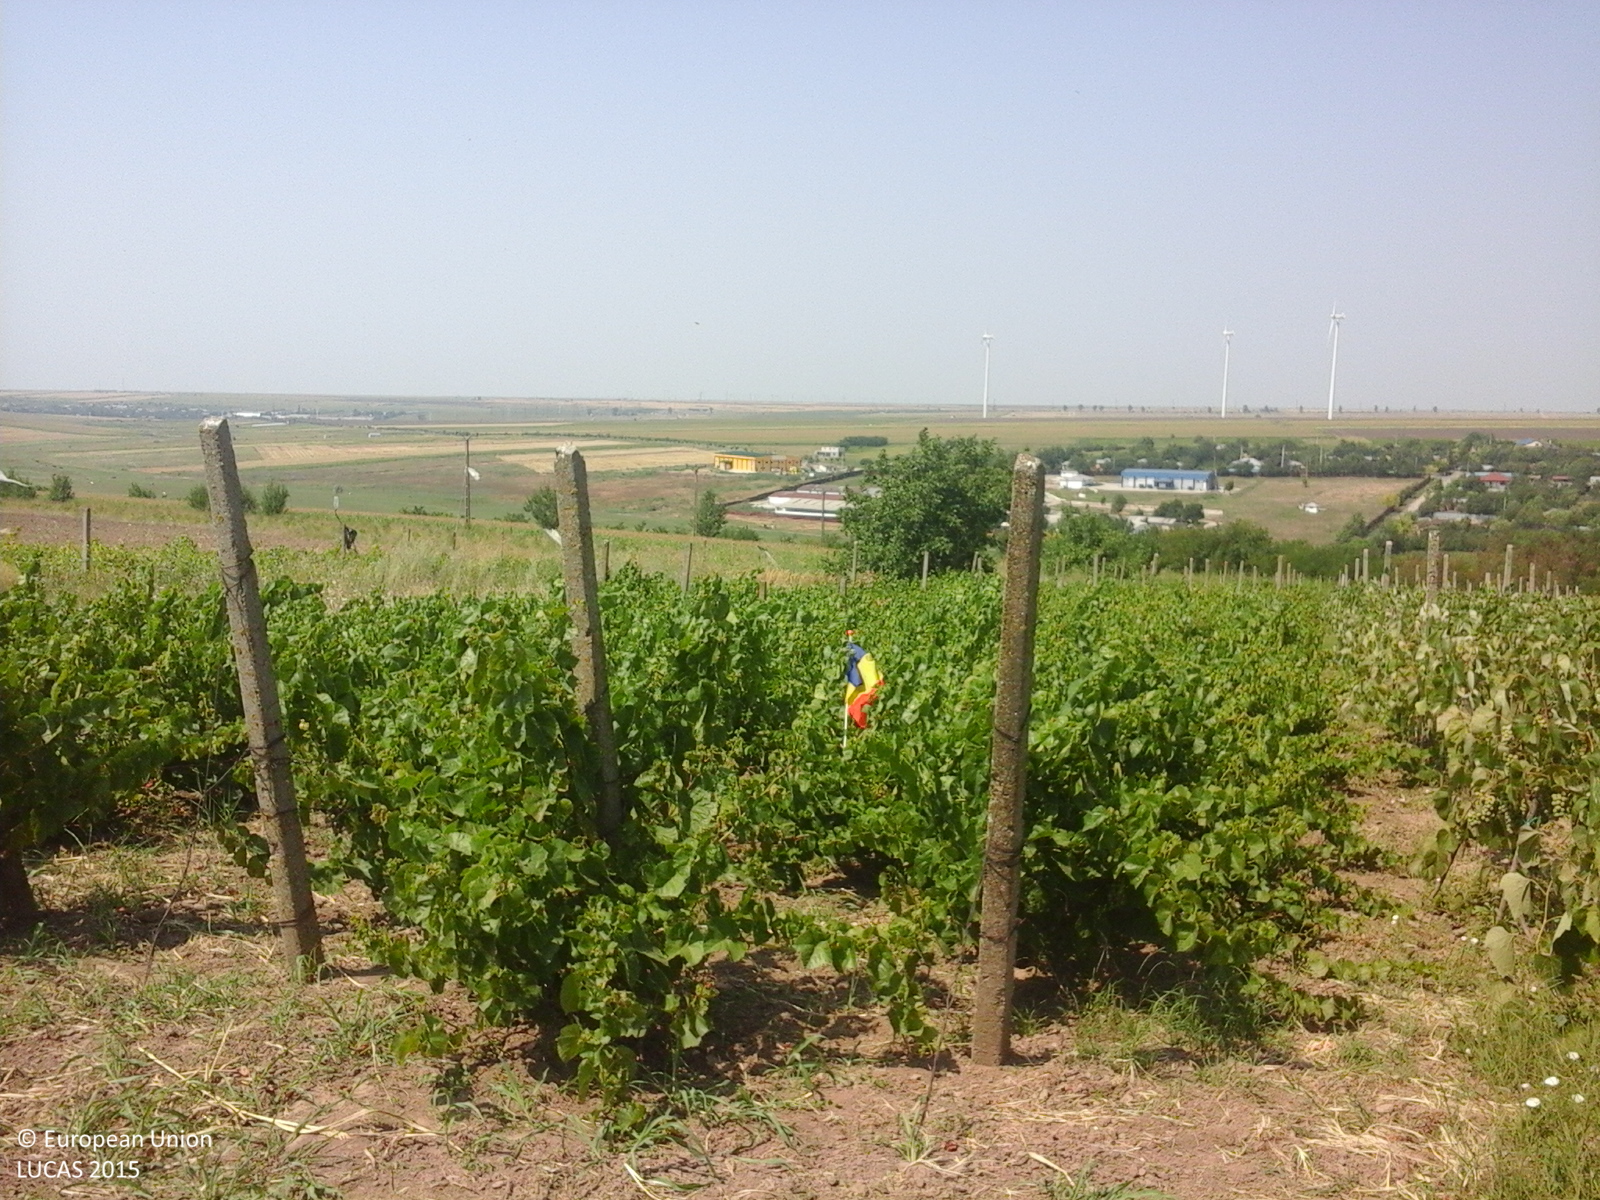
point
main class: Cropland
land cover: Vineyards
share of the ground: > 75 %
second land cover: Other bare soil
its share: > 75 %
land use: Agriculture (excluding fallow land and kitchen gardens)
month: July
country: RO
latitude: 45.5302
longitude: 27.8738
